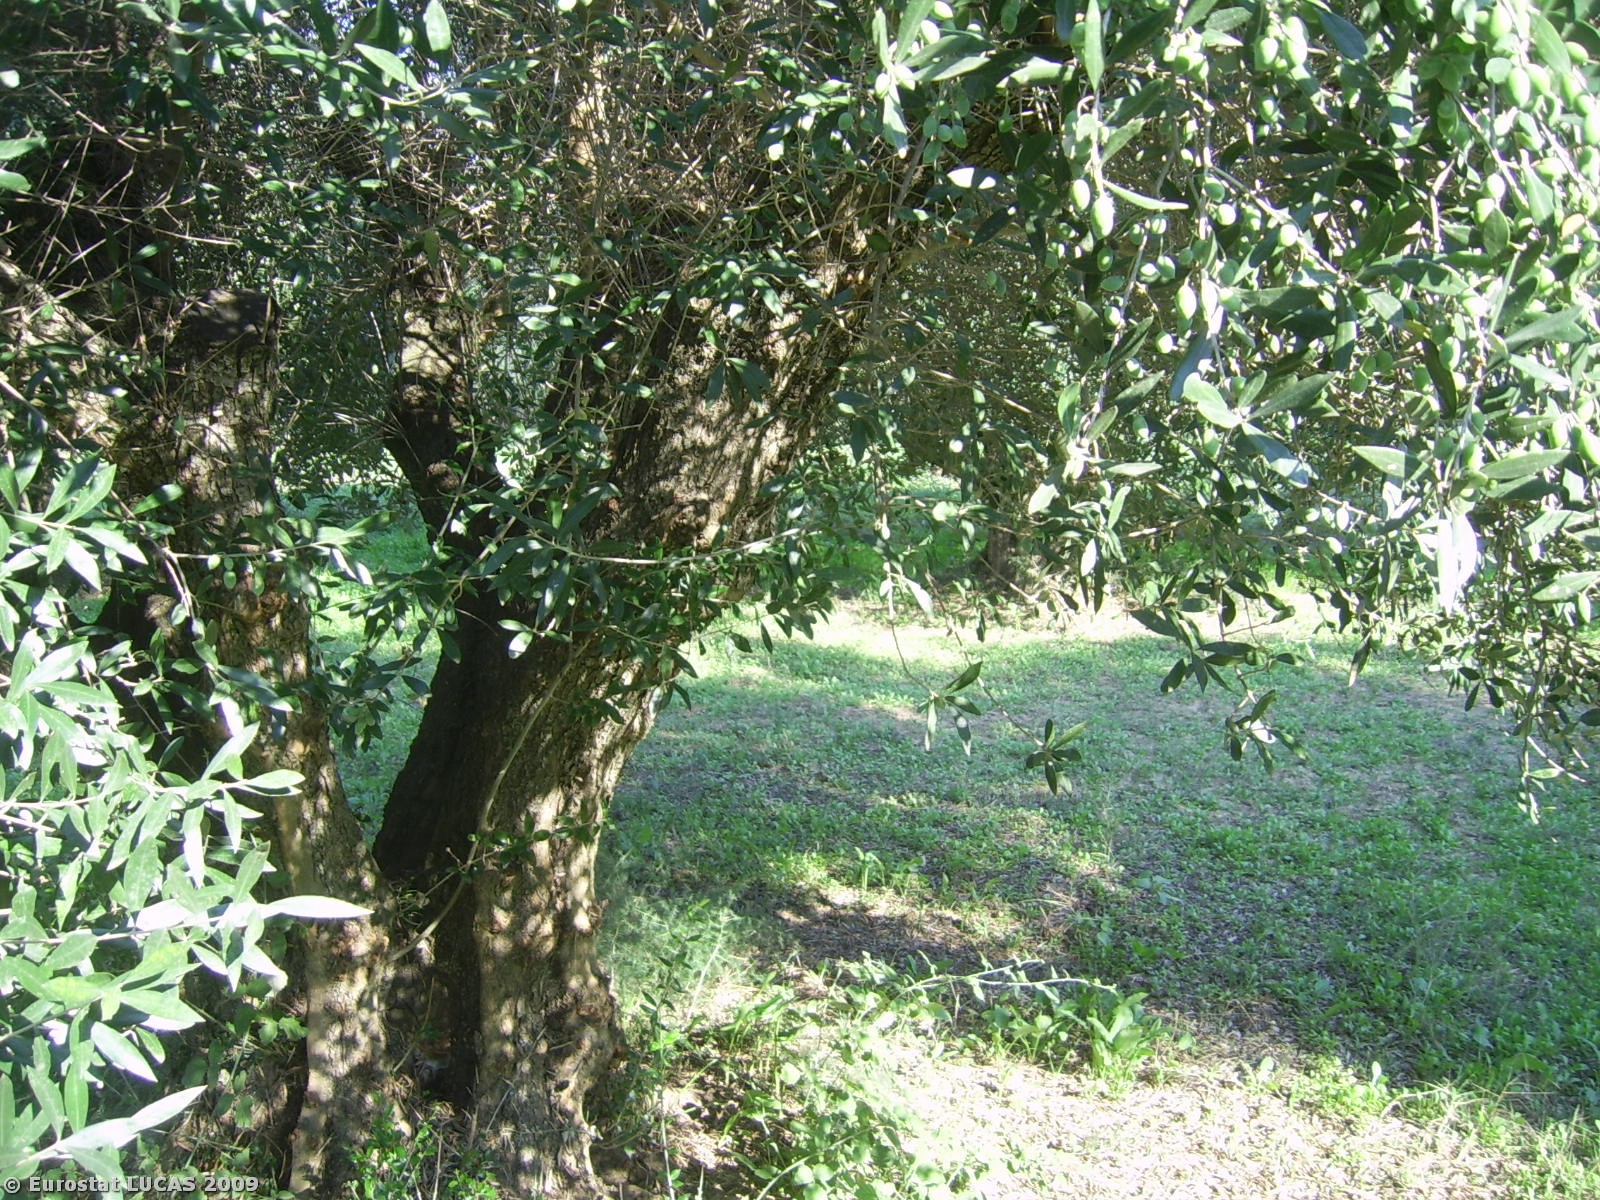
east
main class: Cropland
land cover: Olive groves
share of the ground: 50 - 75 %
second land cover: Grassland with sparse tree/shrub cover
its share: 25 - 50 %
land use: Agriculture (excluding fallow land and kitchen gardens)
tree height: < 5 m
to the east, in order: Olive groves; Grassland with sparse tree/shrub cover; Fences; Shrubland without tree cover; Olive groves; Grassland with sparse tree/shrub cover; Fences; Grassland without tree/shrub cover; Fences; Olive groves; Grassland with sparse tree/shrub cover; Paved roads, cycling and walking lanes; Fences; Artificial constructions in urban areas; Fences; Electric lines; Paved roads, cycling and walking lanes; Fences; Electric lines; Grassland without tree/shrub cover; Fences; Grass margins; Ditches and canals; Shrubland without tree cover
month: October
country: GR
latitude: 37.8153
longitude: 21.3536
